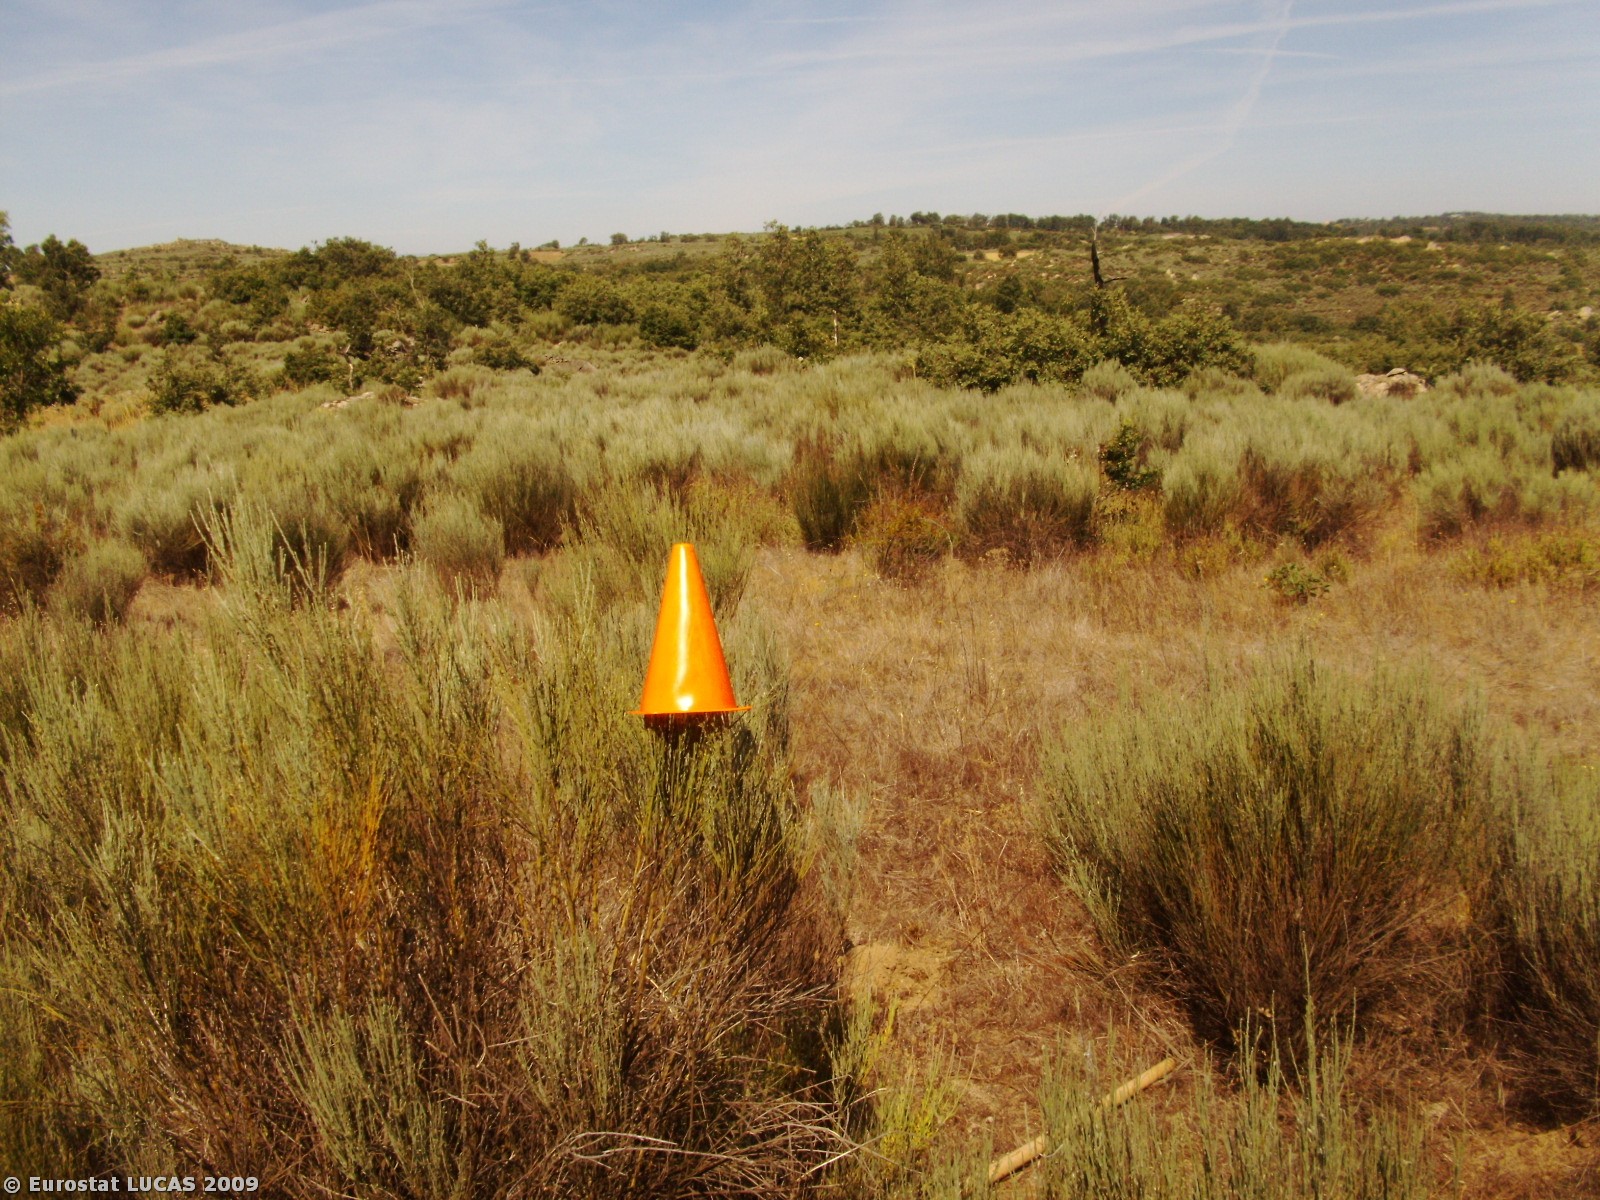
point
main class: Shrubland
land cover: Shrubland without tree cover
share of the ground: > 75 %
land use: Fallow land
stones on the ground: > 50 %
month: July
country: PT
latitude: 40.4556
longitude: -7.0684
